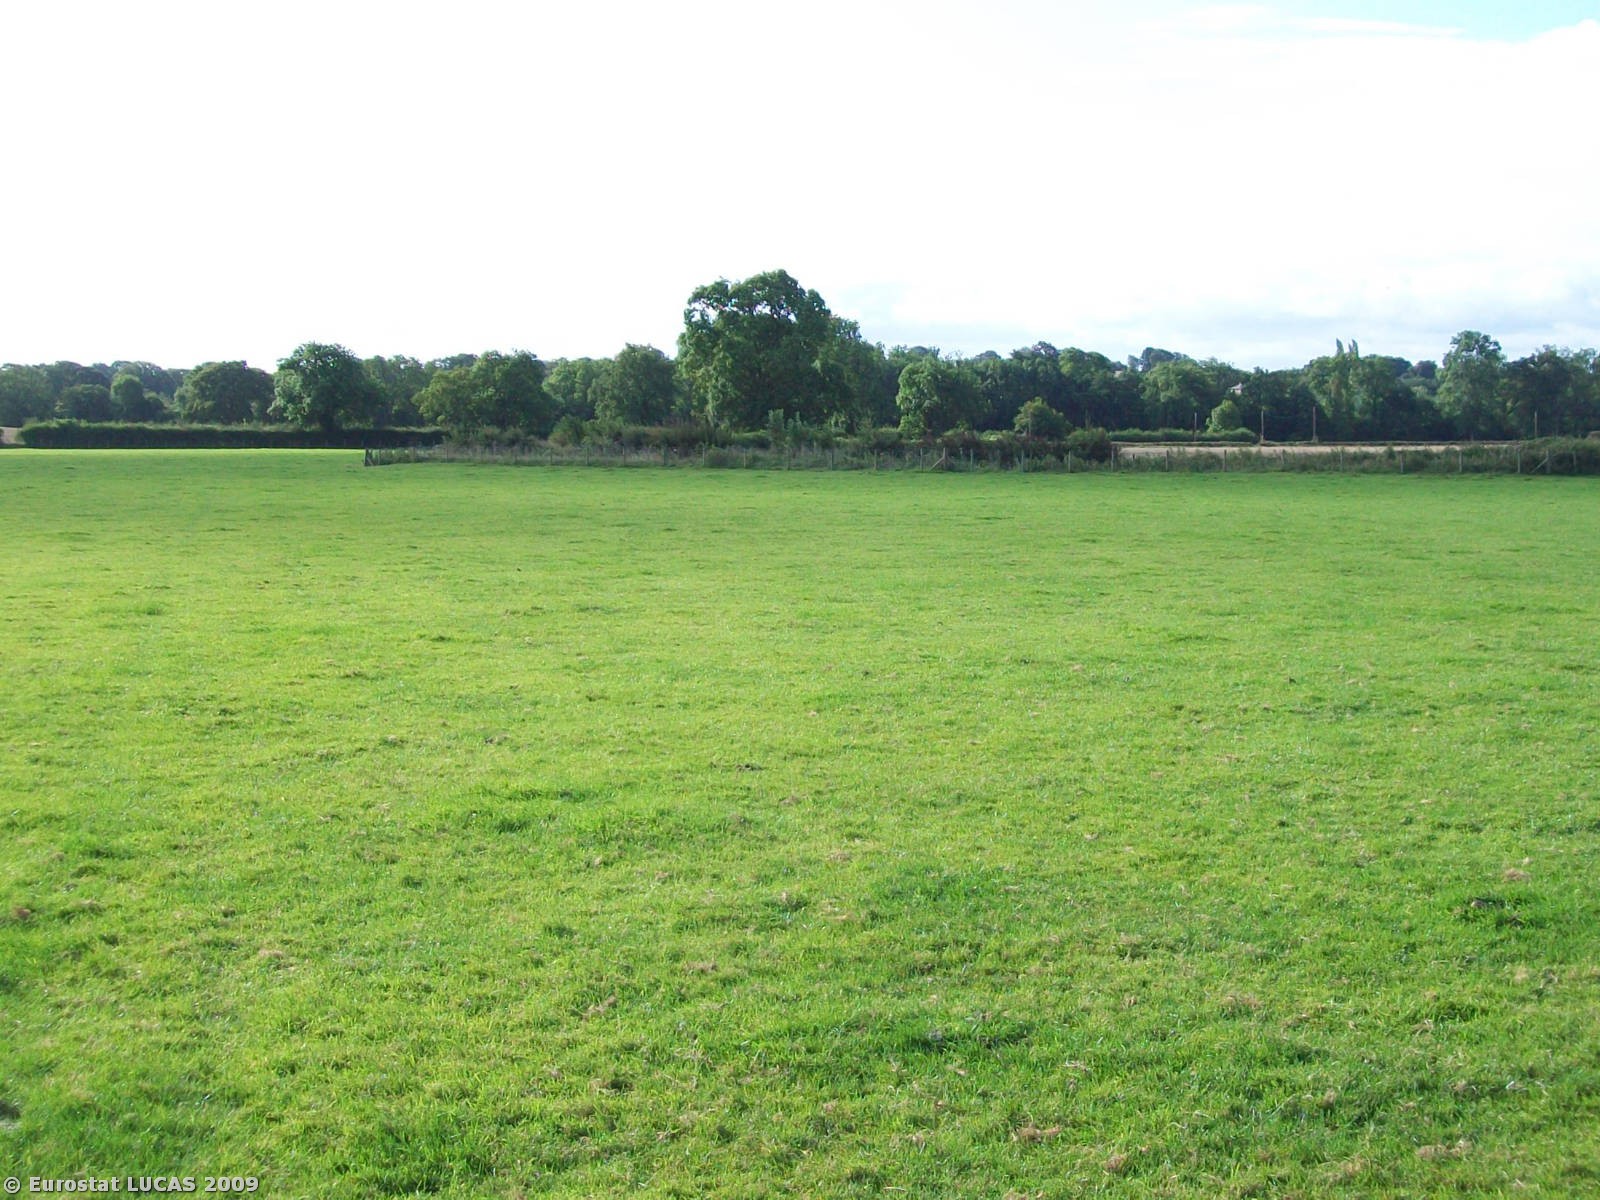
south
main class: Grassland
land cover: Grassland without tree/shrub cover
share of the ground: > 75 %
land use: Agriculture (excluding fallow land and kitchen gardens)
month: September
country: GB
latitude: 52.0793
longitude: -2.4837
